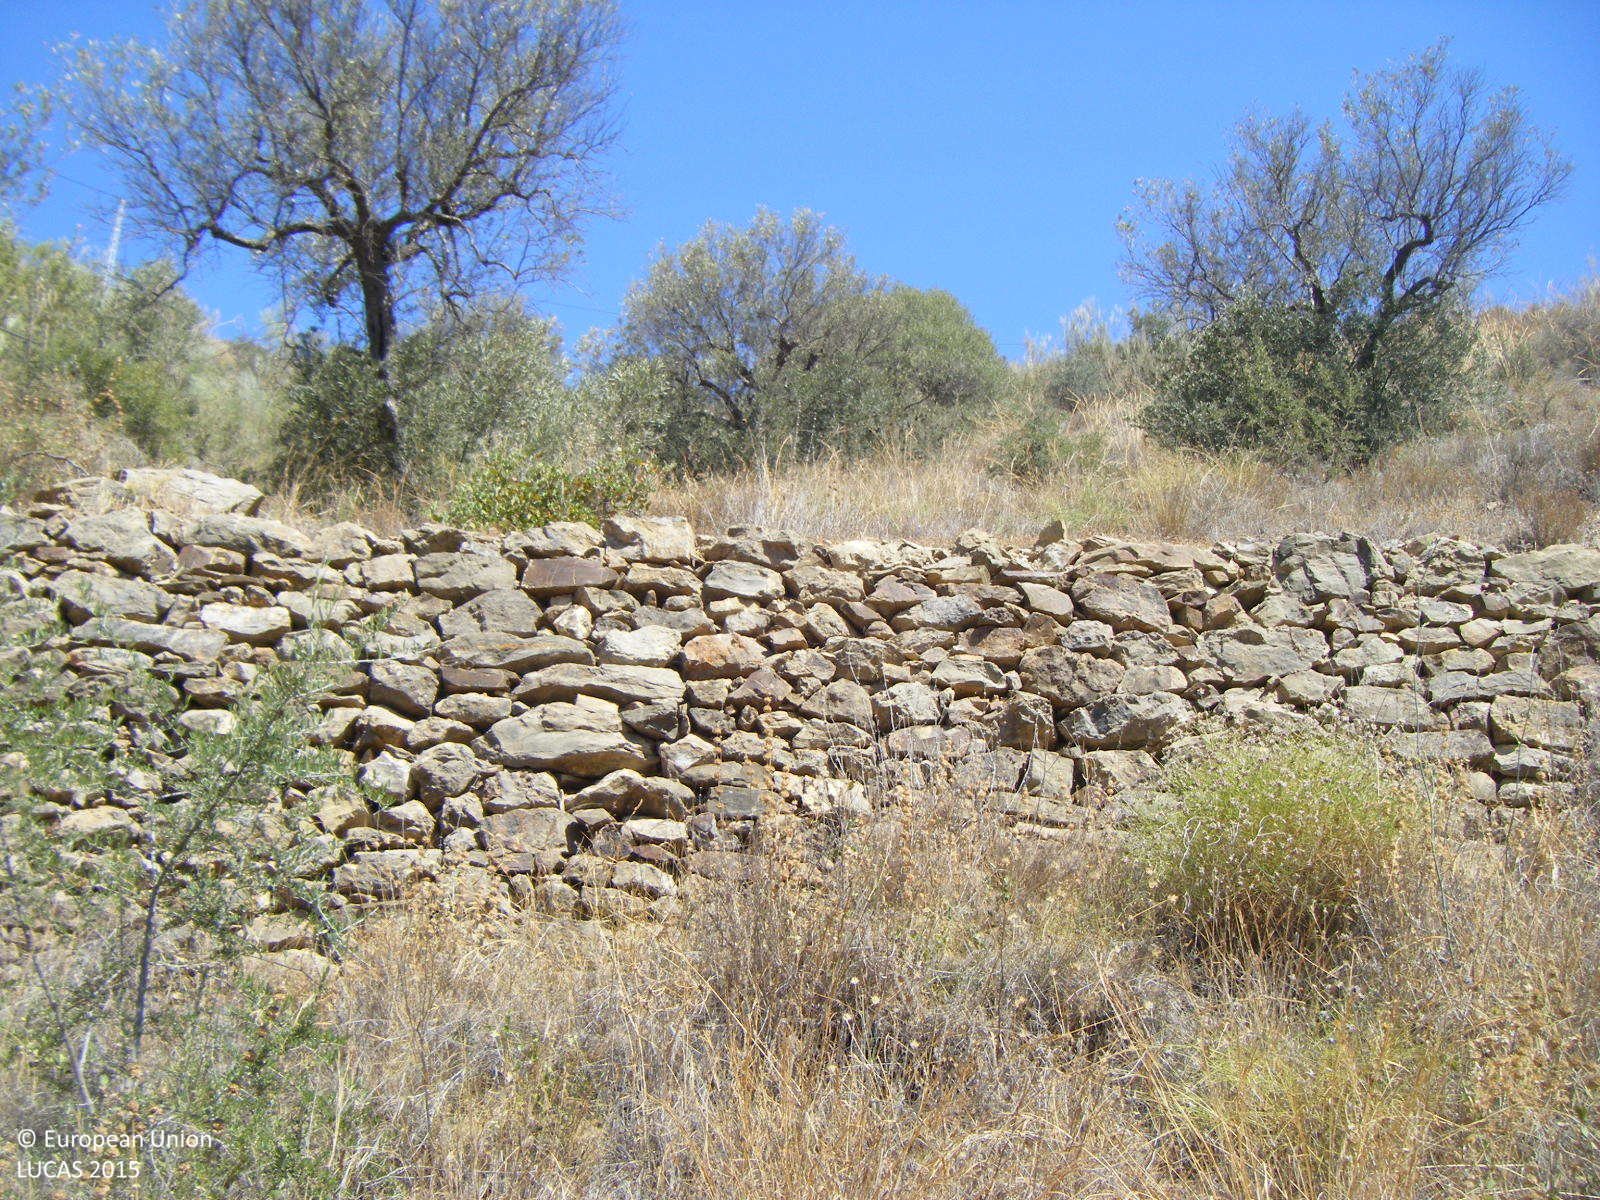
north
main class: Cropland
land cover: Olive groves
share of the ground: 10 - 25 %
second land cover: Spontaneously vegetated surfaces
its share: > 75 %
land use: Abandoned areas
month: July
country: ES
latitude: 36.7326
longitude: -4.3110
